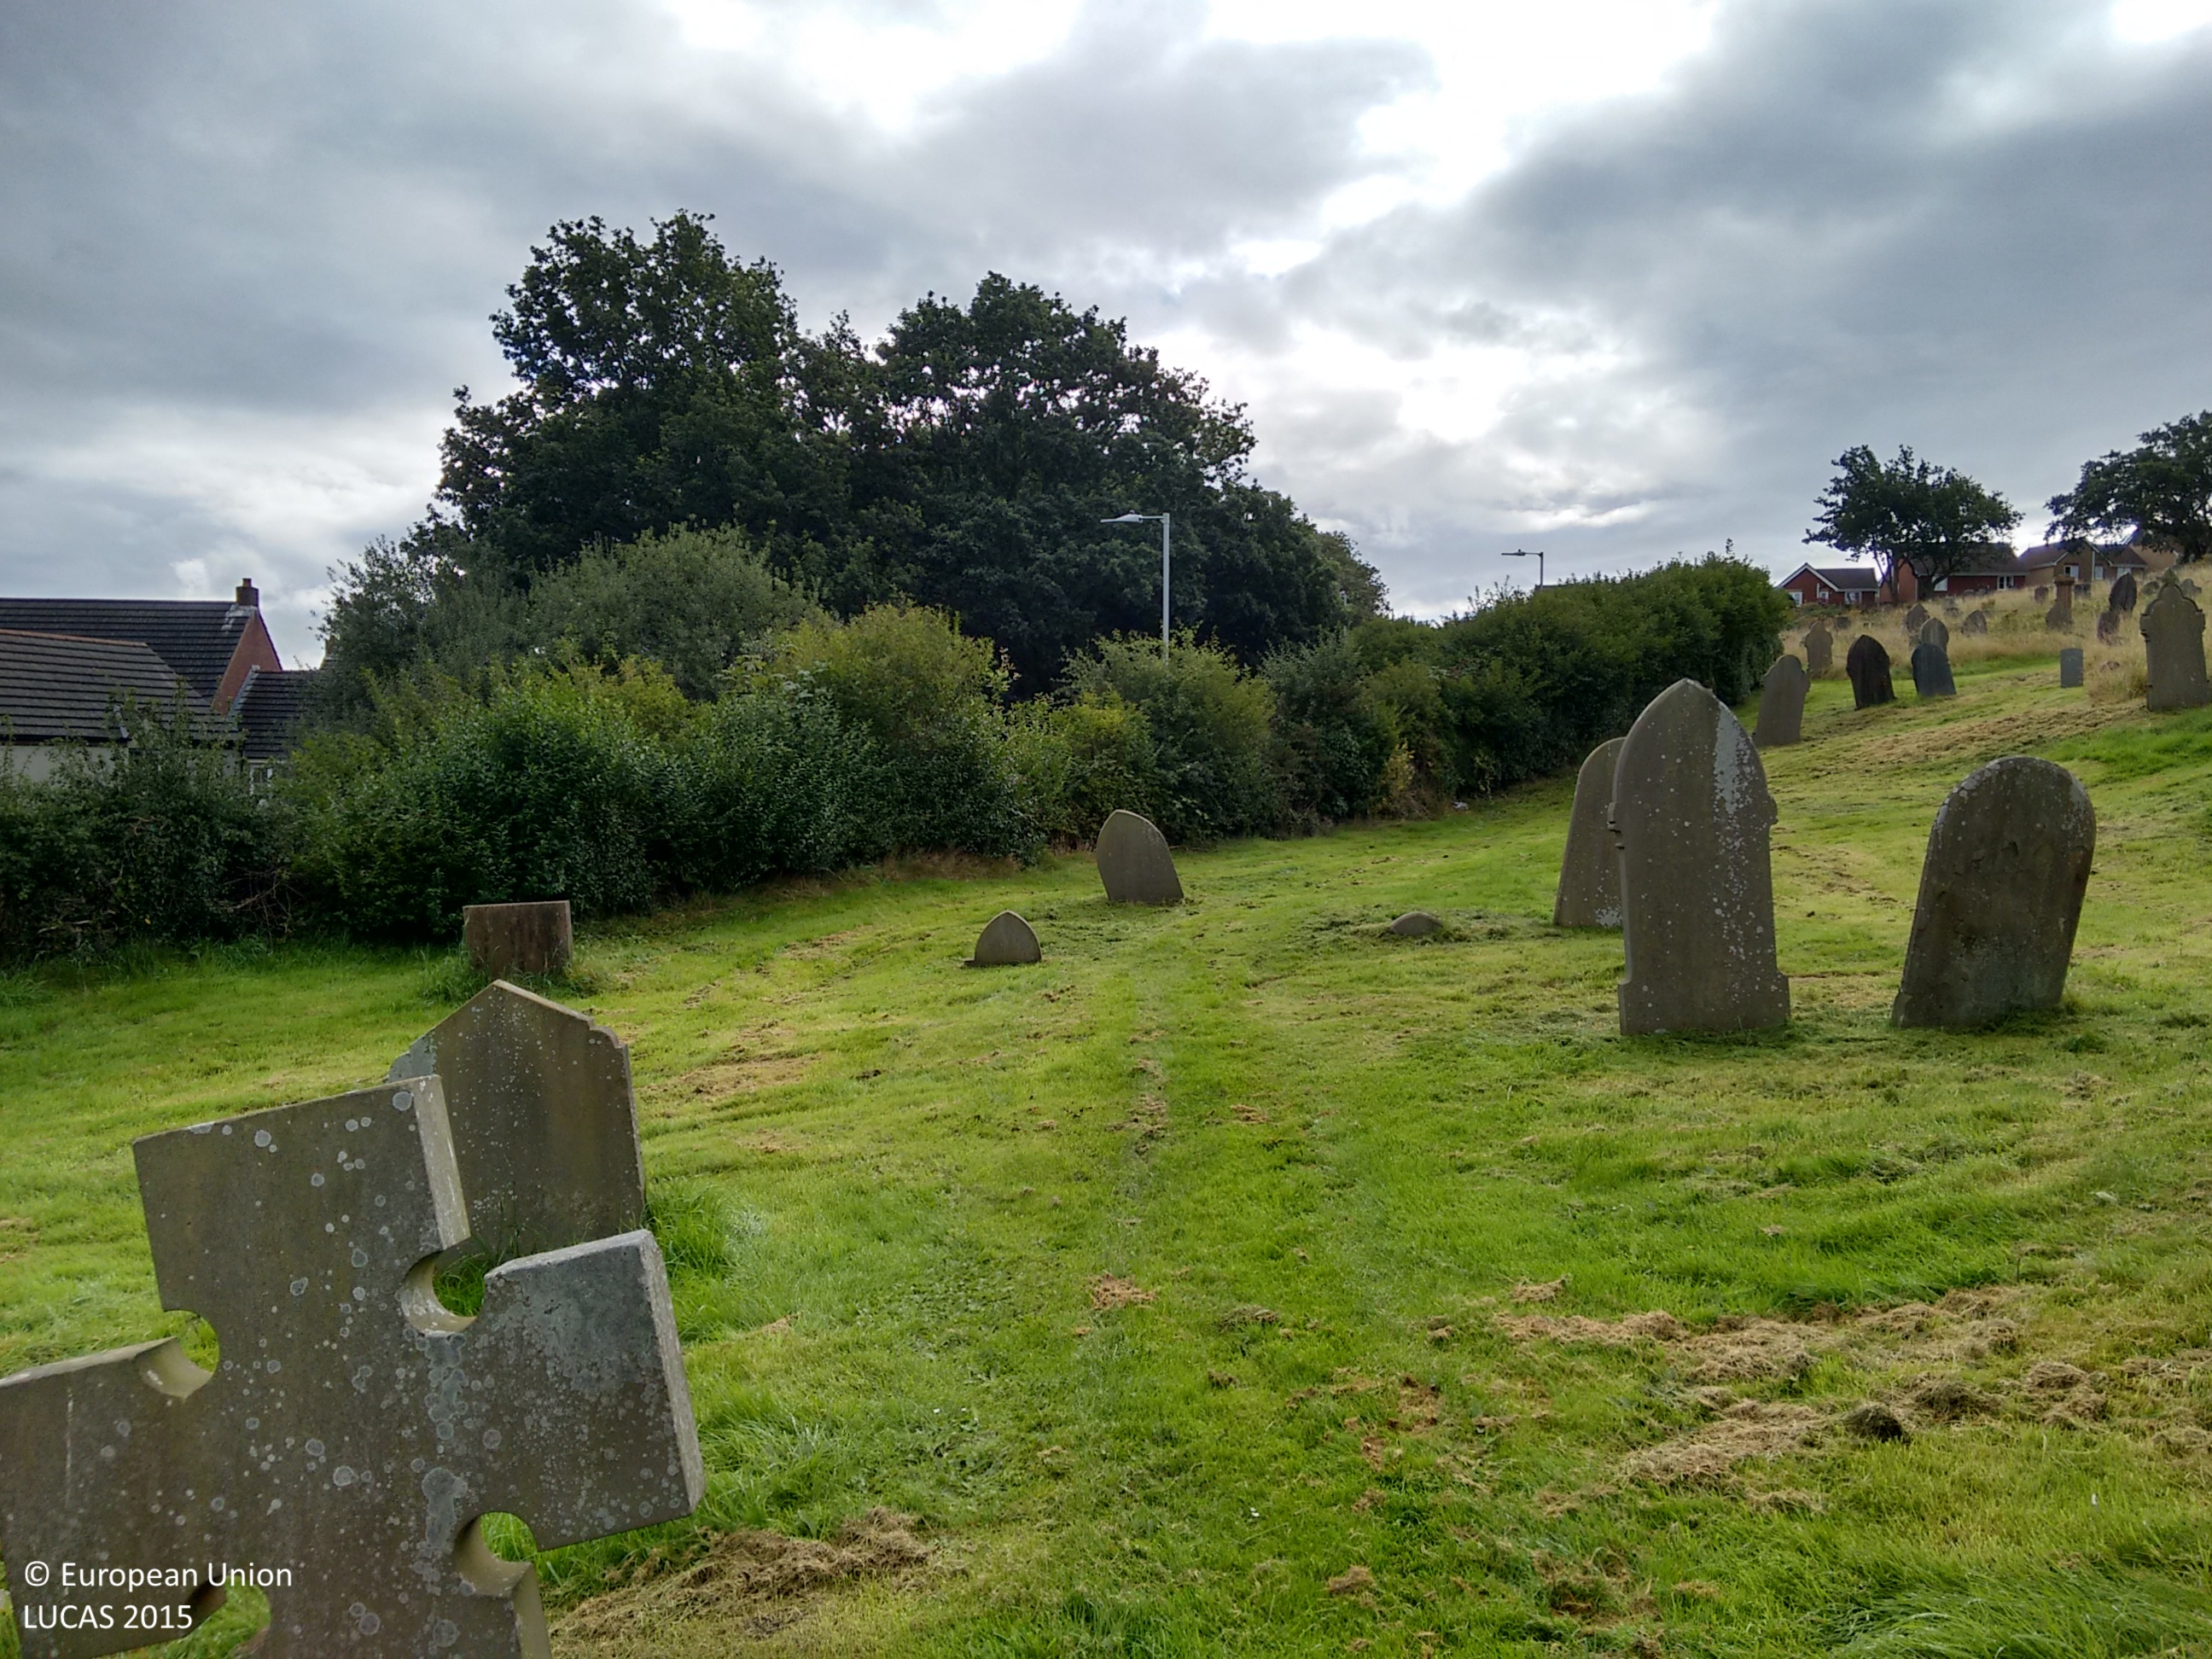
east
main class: Grassland
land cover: Grassland with sparse tree/shrub cover
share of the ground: > 75 %
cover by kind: herbaceous plants 95 %, broadleaved forest trees 5 %
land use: Community services
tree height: > 5 m
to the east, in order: Grassland with sparse tree/shrub cover; Fences; Abandoned hedges; Grass margins; Paved roads, cycling and walking lanes; Grass margins; Fences; Broadleaved woodland; Artificial constructions in urban areas; Broadleaved woodland
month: September
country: GB
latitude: 51.6361
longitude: -3.9793
